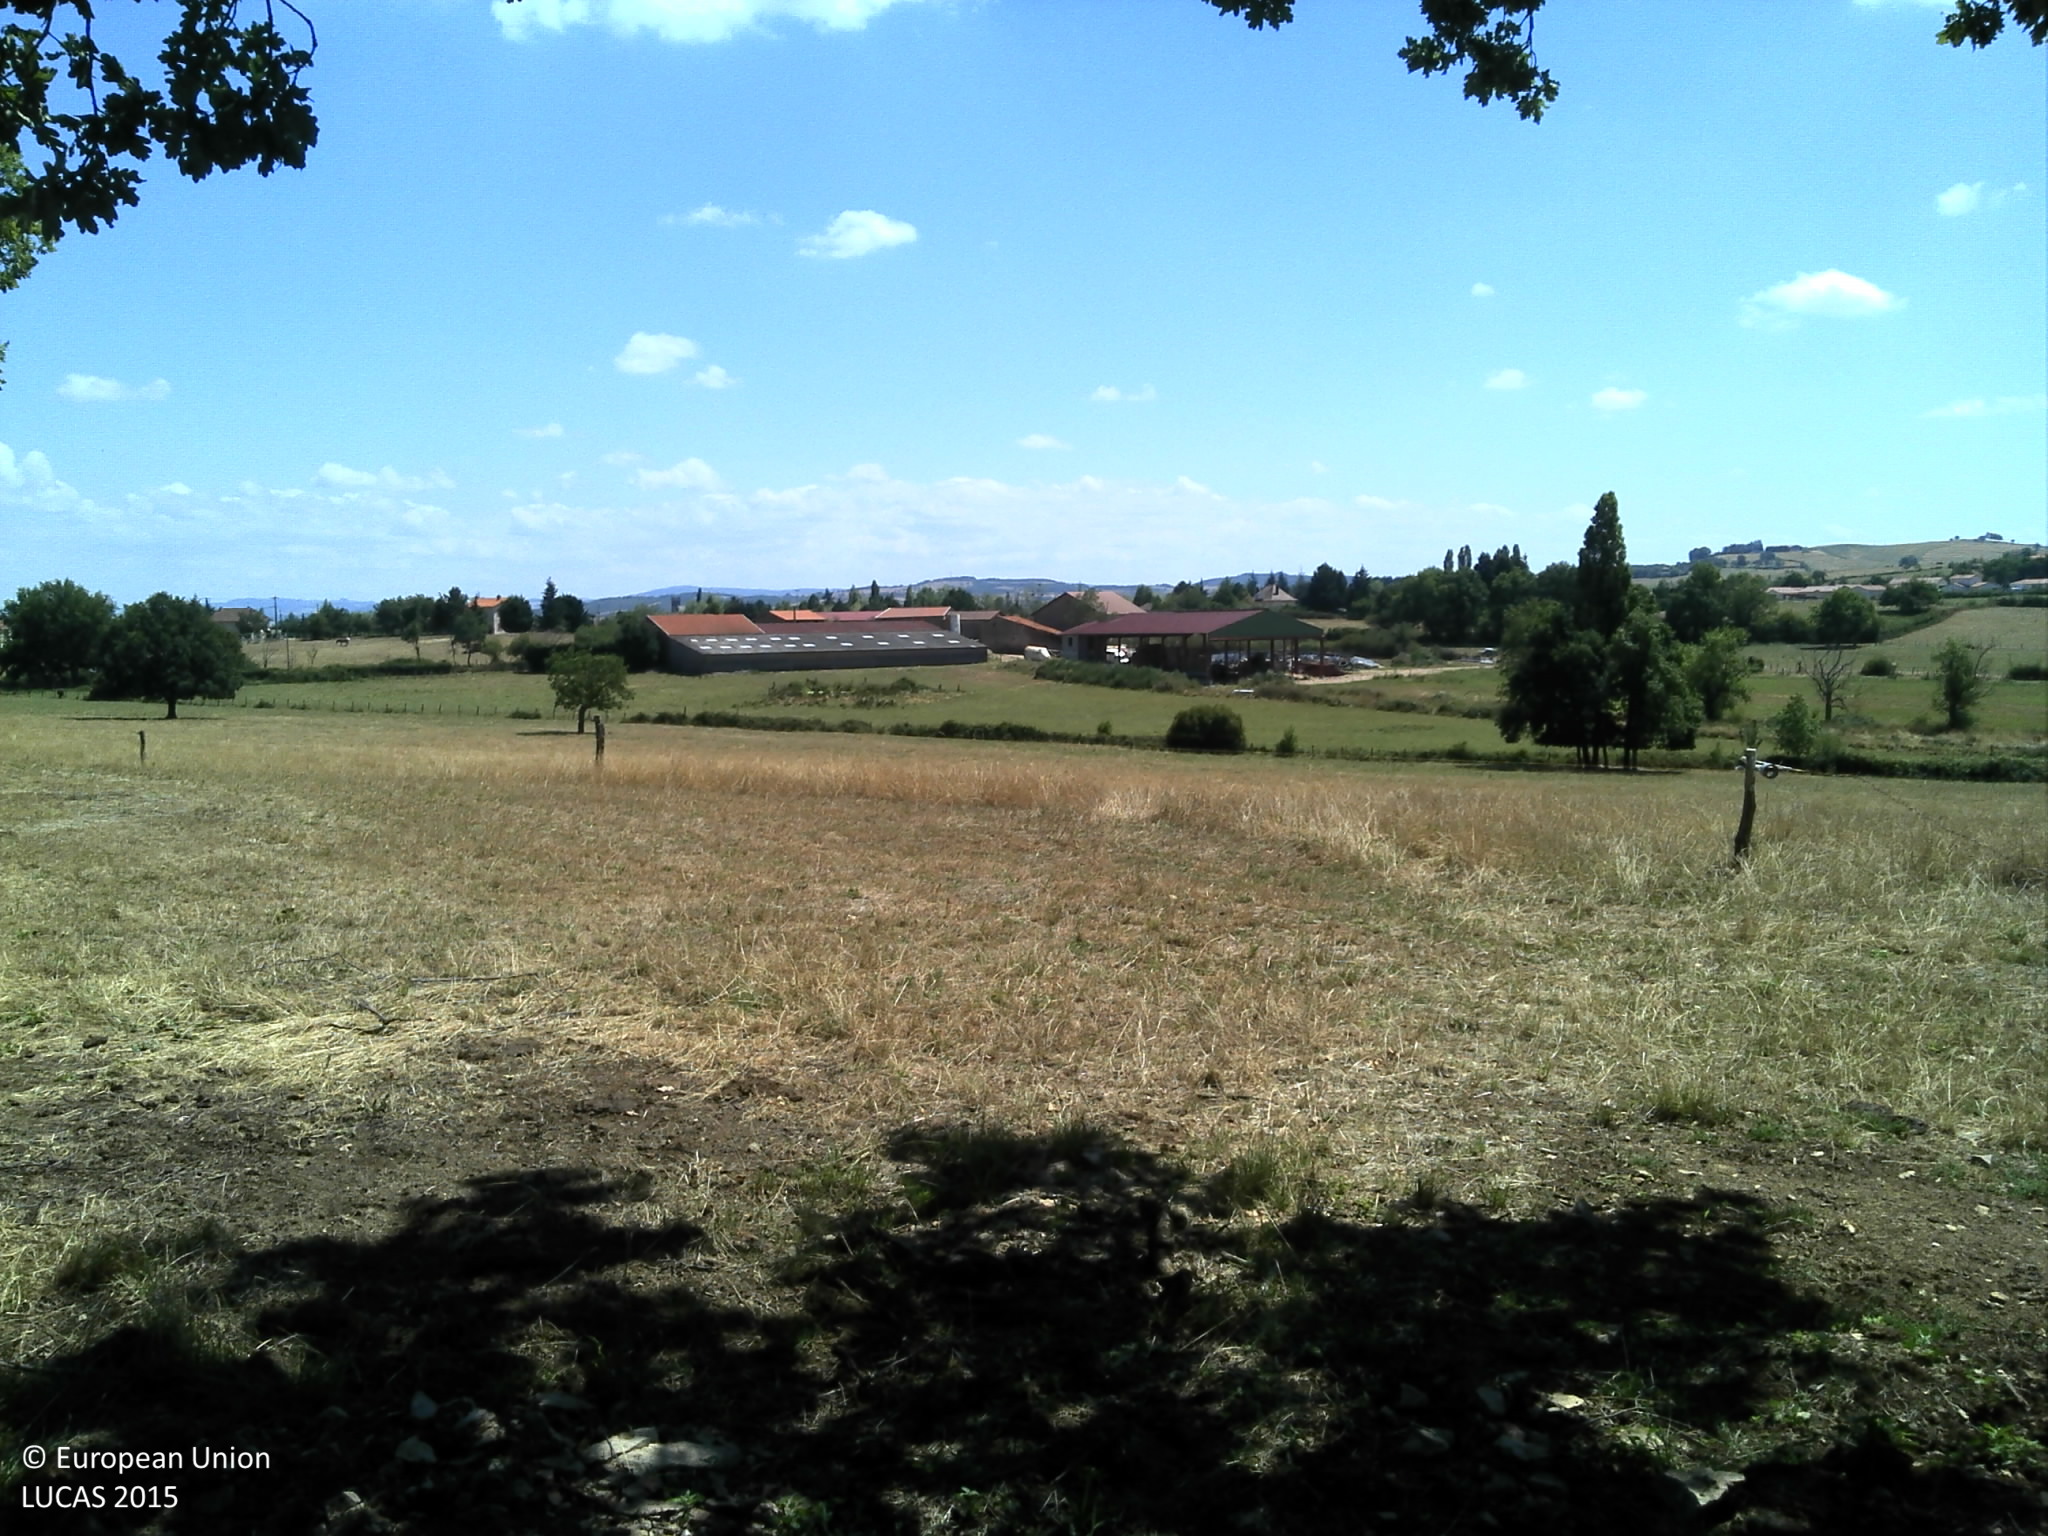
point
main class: Grassland
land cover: Grassland without tree/shrub cover
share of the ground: > 75 %
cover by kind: herbaceous plants 100 %
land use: Agriculture (excluding fallow land and kitchen gardens)
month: July
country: FR
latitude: 45.9704
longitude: 4.0782
